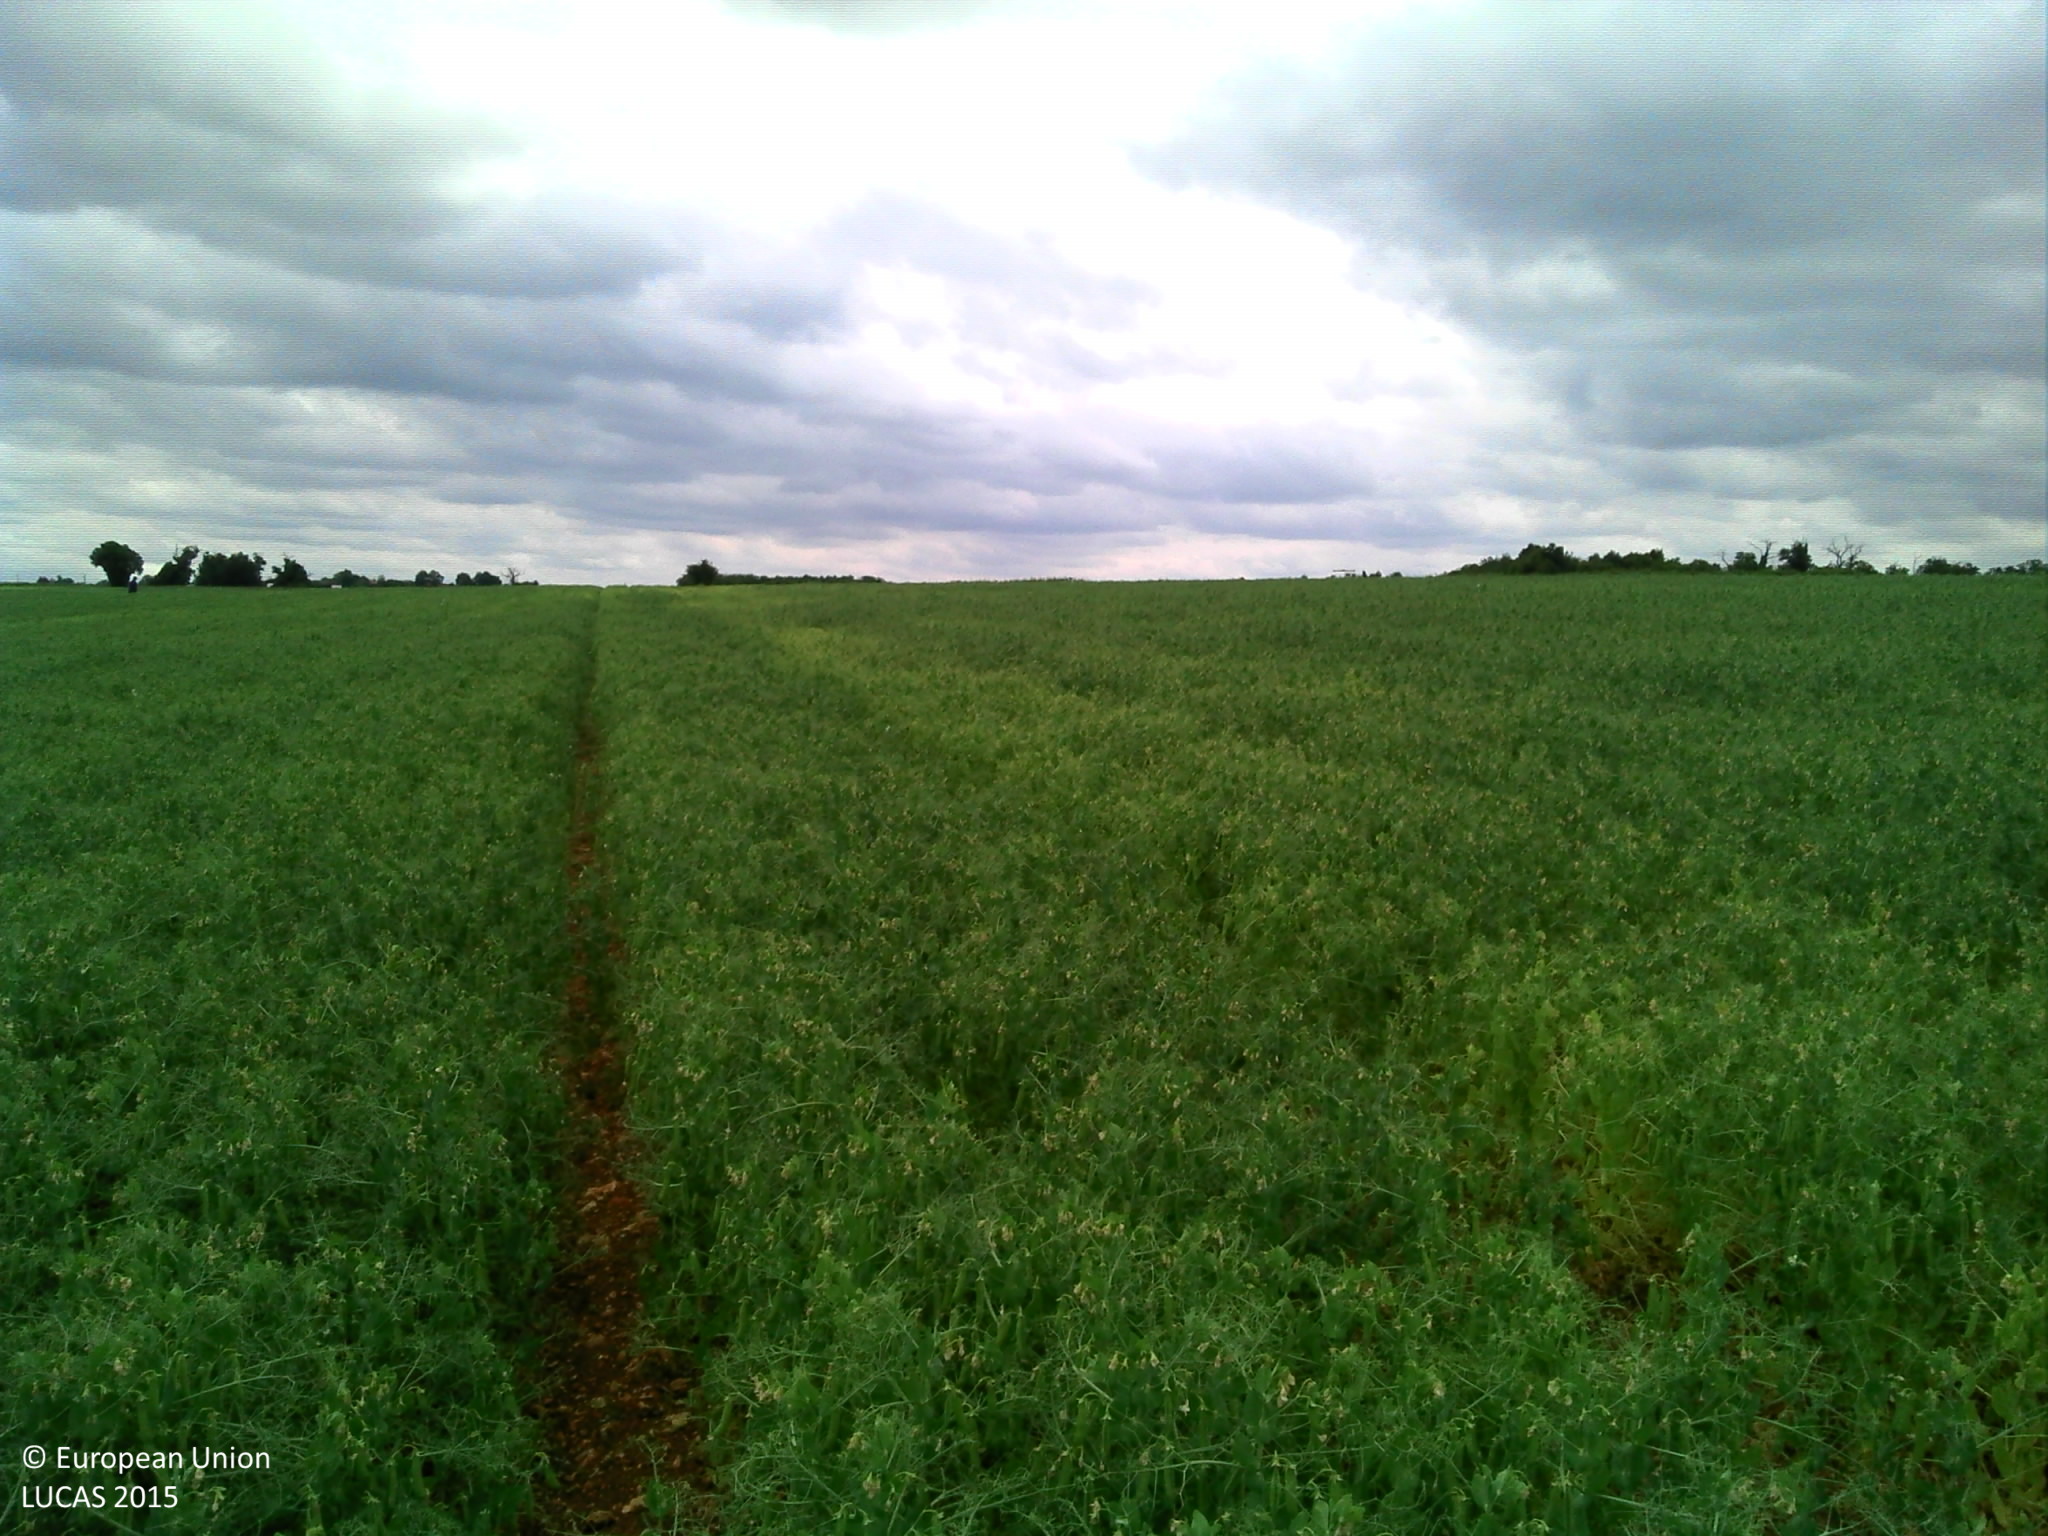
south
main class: Cropland
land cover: Dry pulses
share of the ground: > 75 %
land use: Agriculture (excluding fallow land and kitchen gardens)
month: June
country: FR
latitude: 46.0368
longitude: 0.3052
